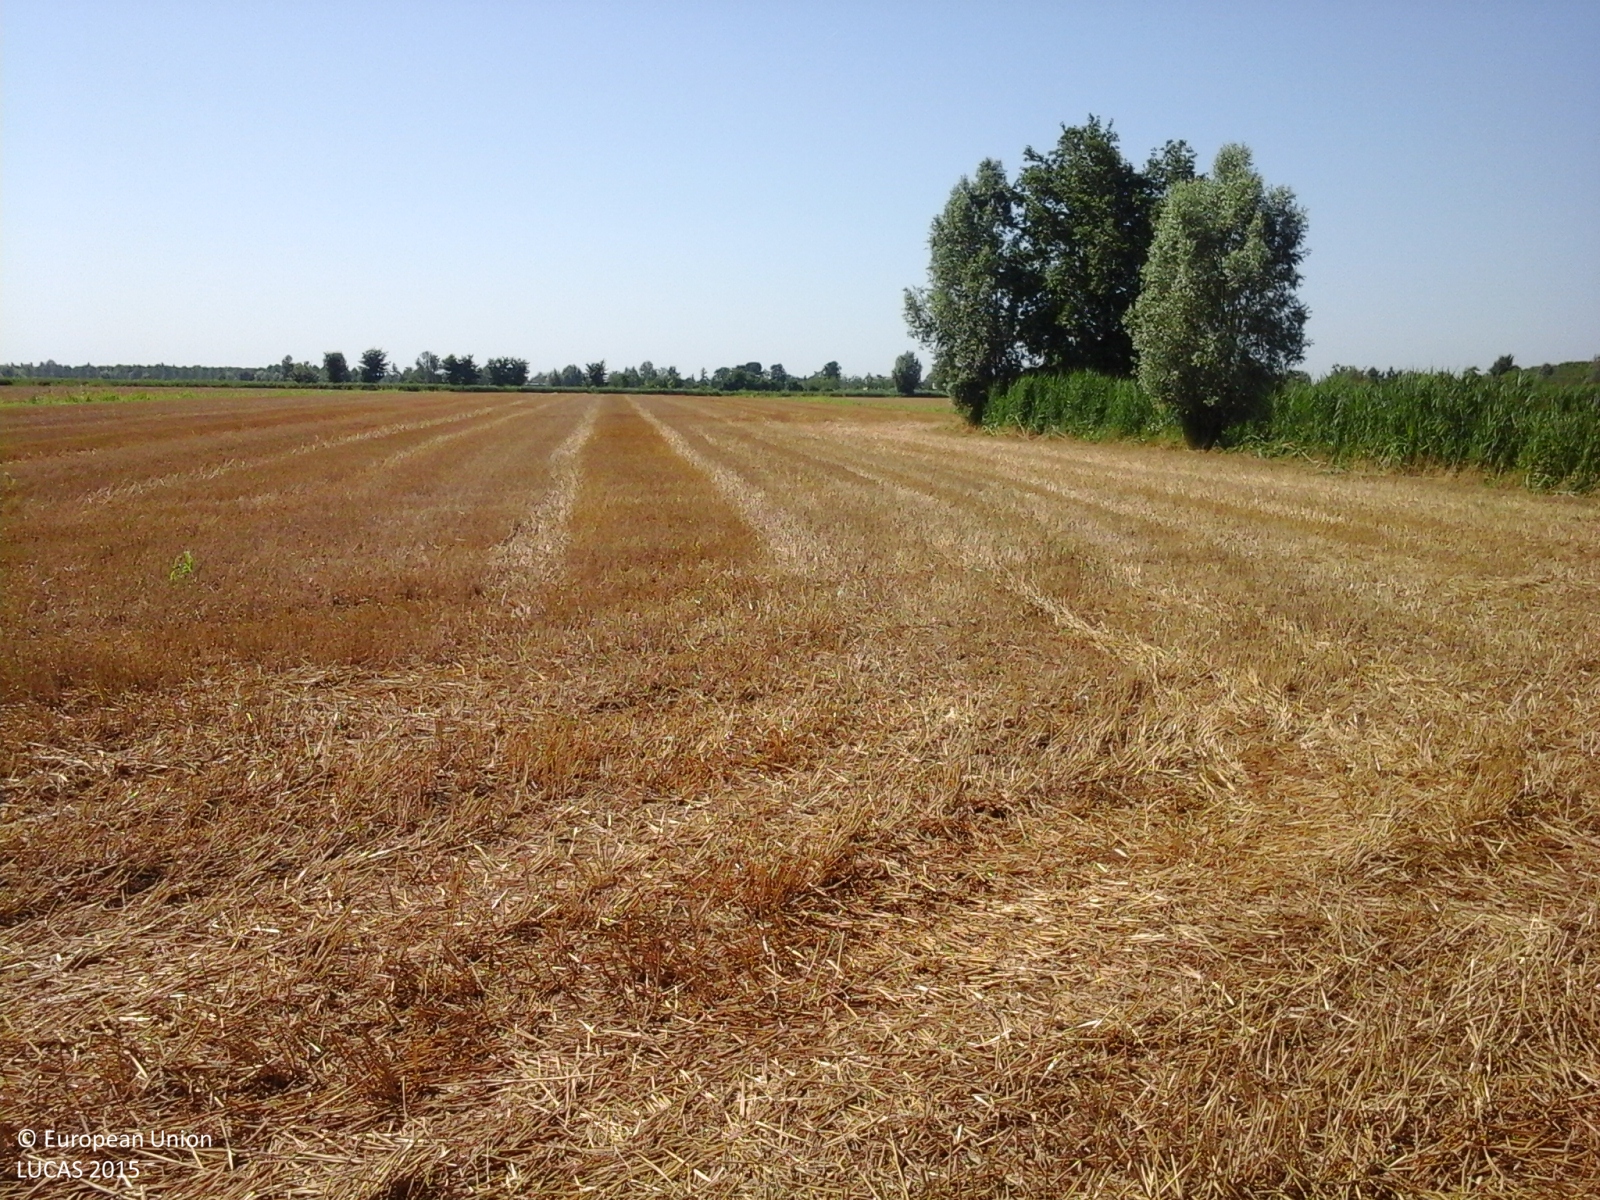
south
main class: Cropland
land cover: Common wheat
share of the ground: > 75 %
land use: Agriculture (excluding fallow land and kitchen gardens)
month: July
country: IT
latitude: 45.6947
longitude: 12.3467
